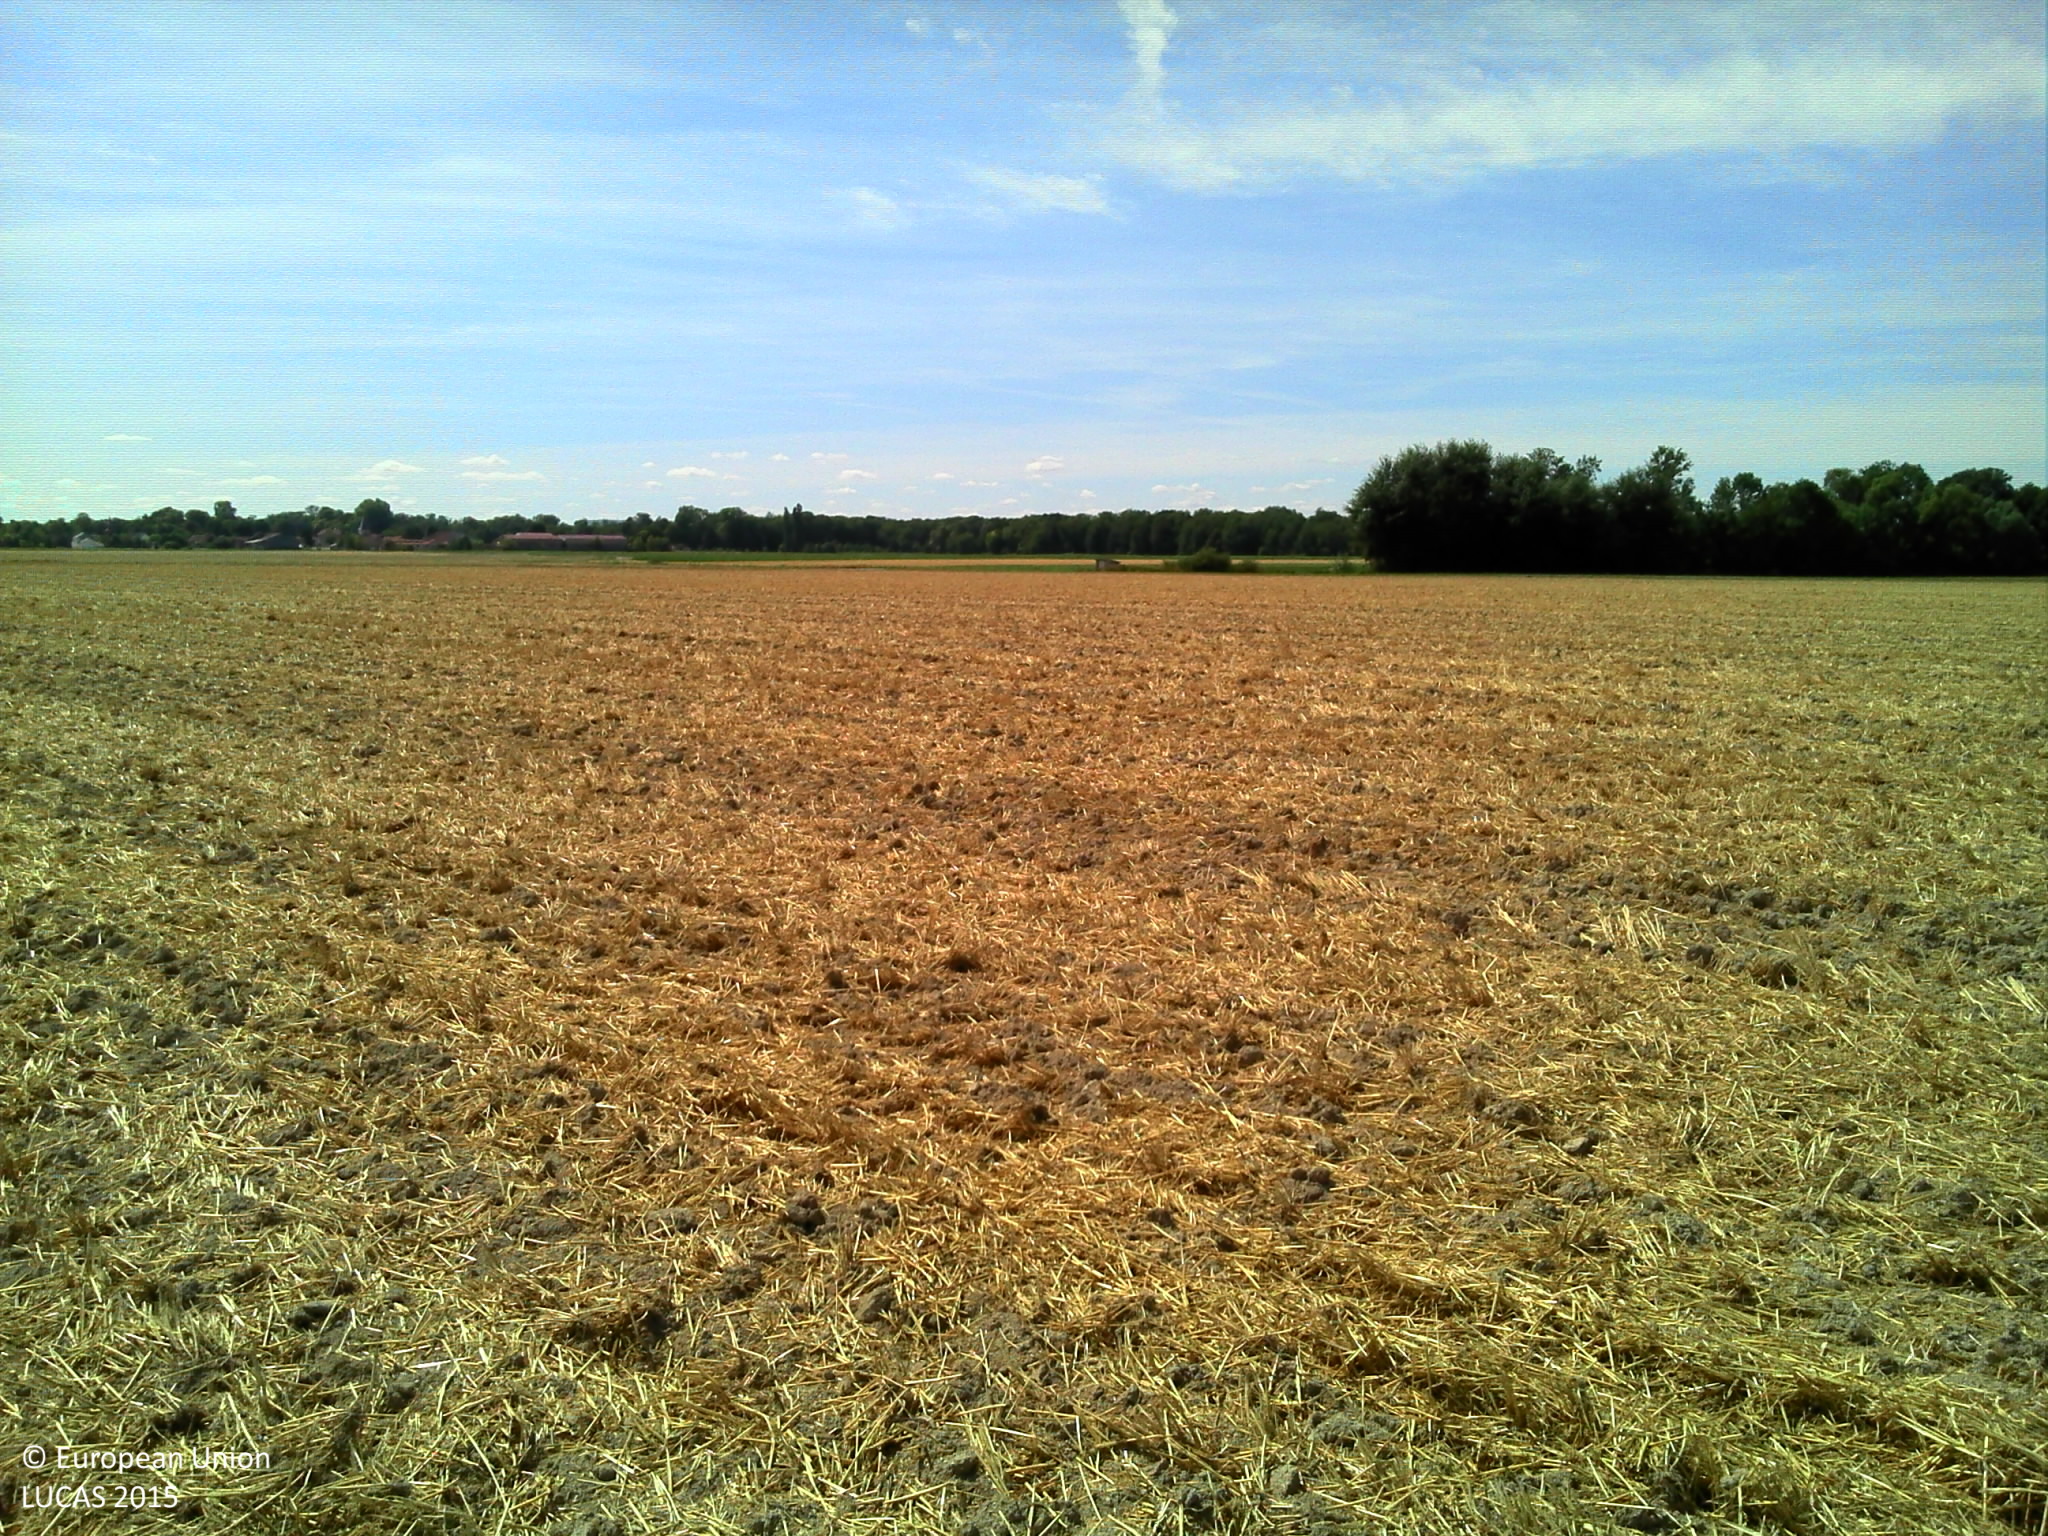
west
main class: Cropland
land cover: Common wheat
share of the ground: > 75 %
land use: Agriculture (excluding fallow land and kitchen gardens)
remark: Harvested field
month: August
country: FR
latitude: 48.9529
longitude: 4.1646
